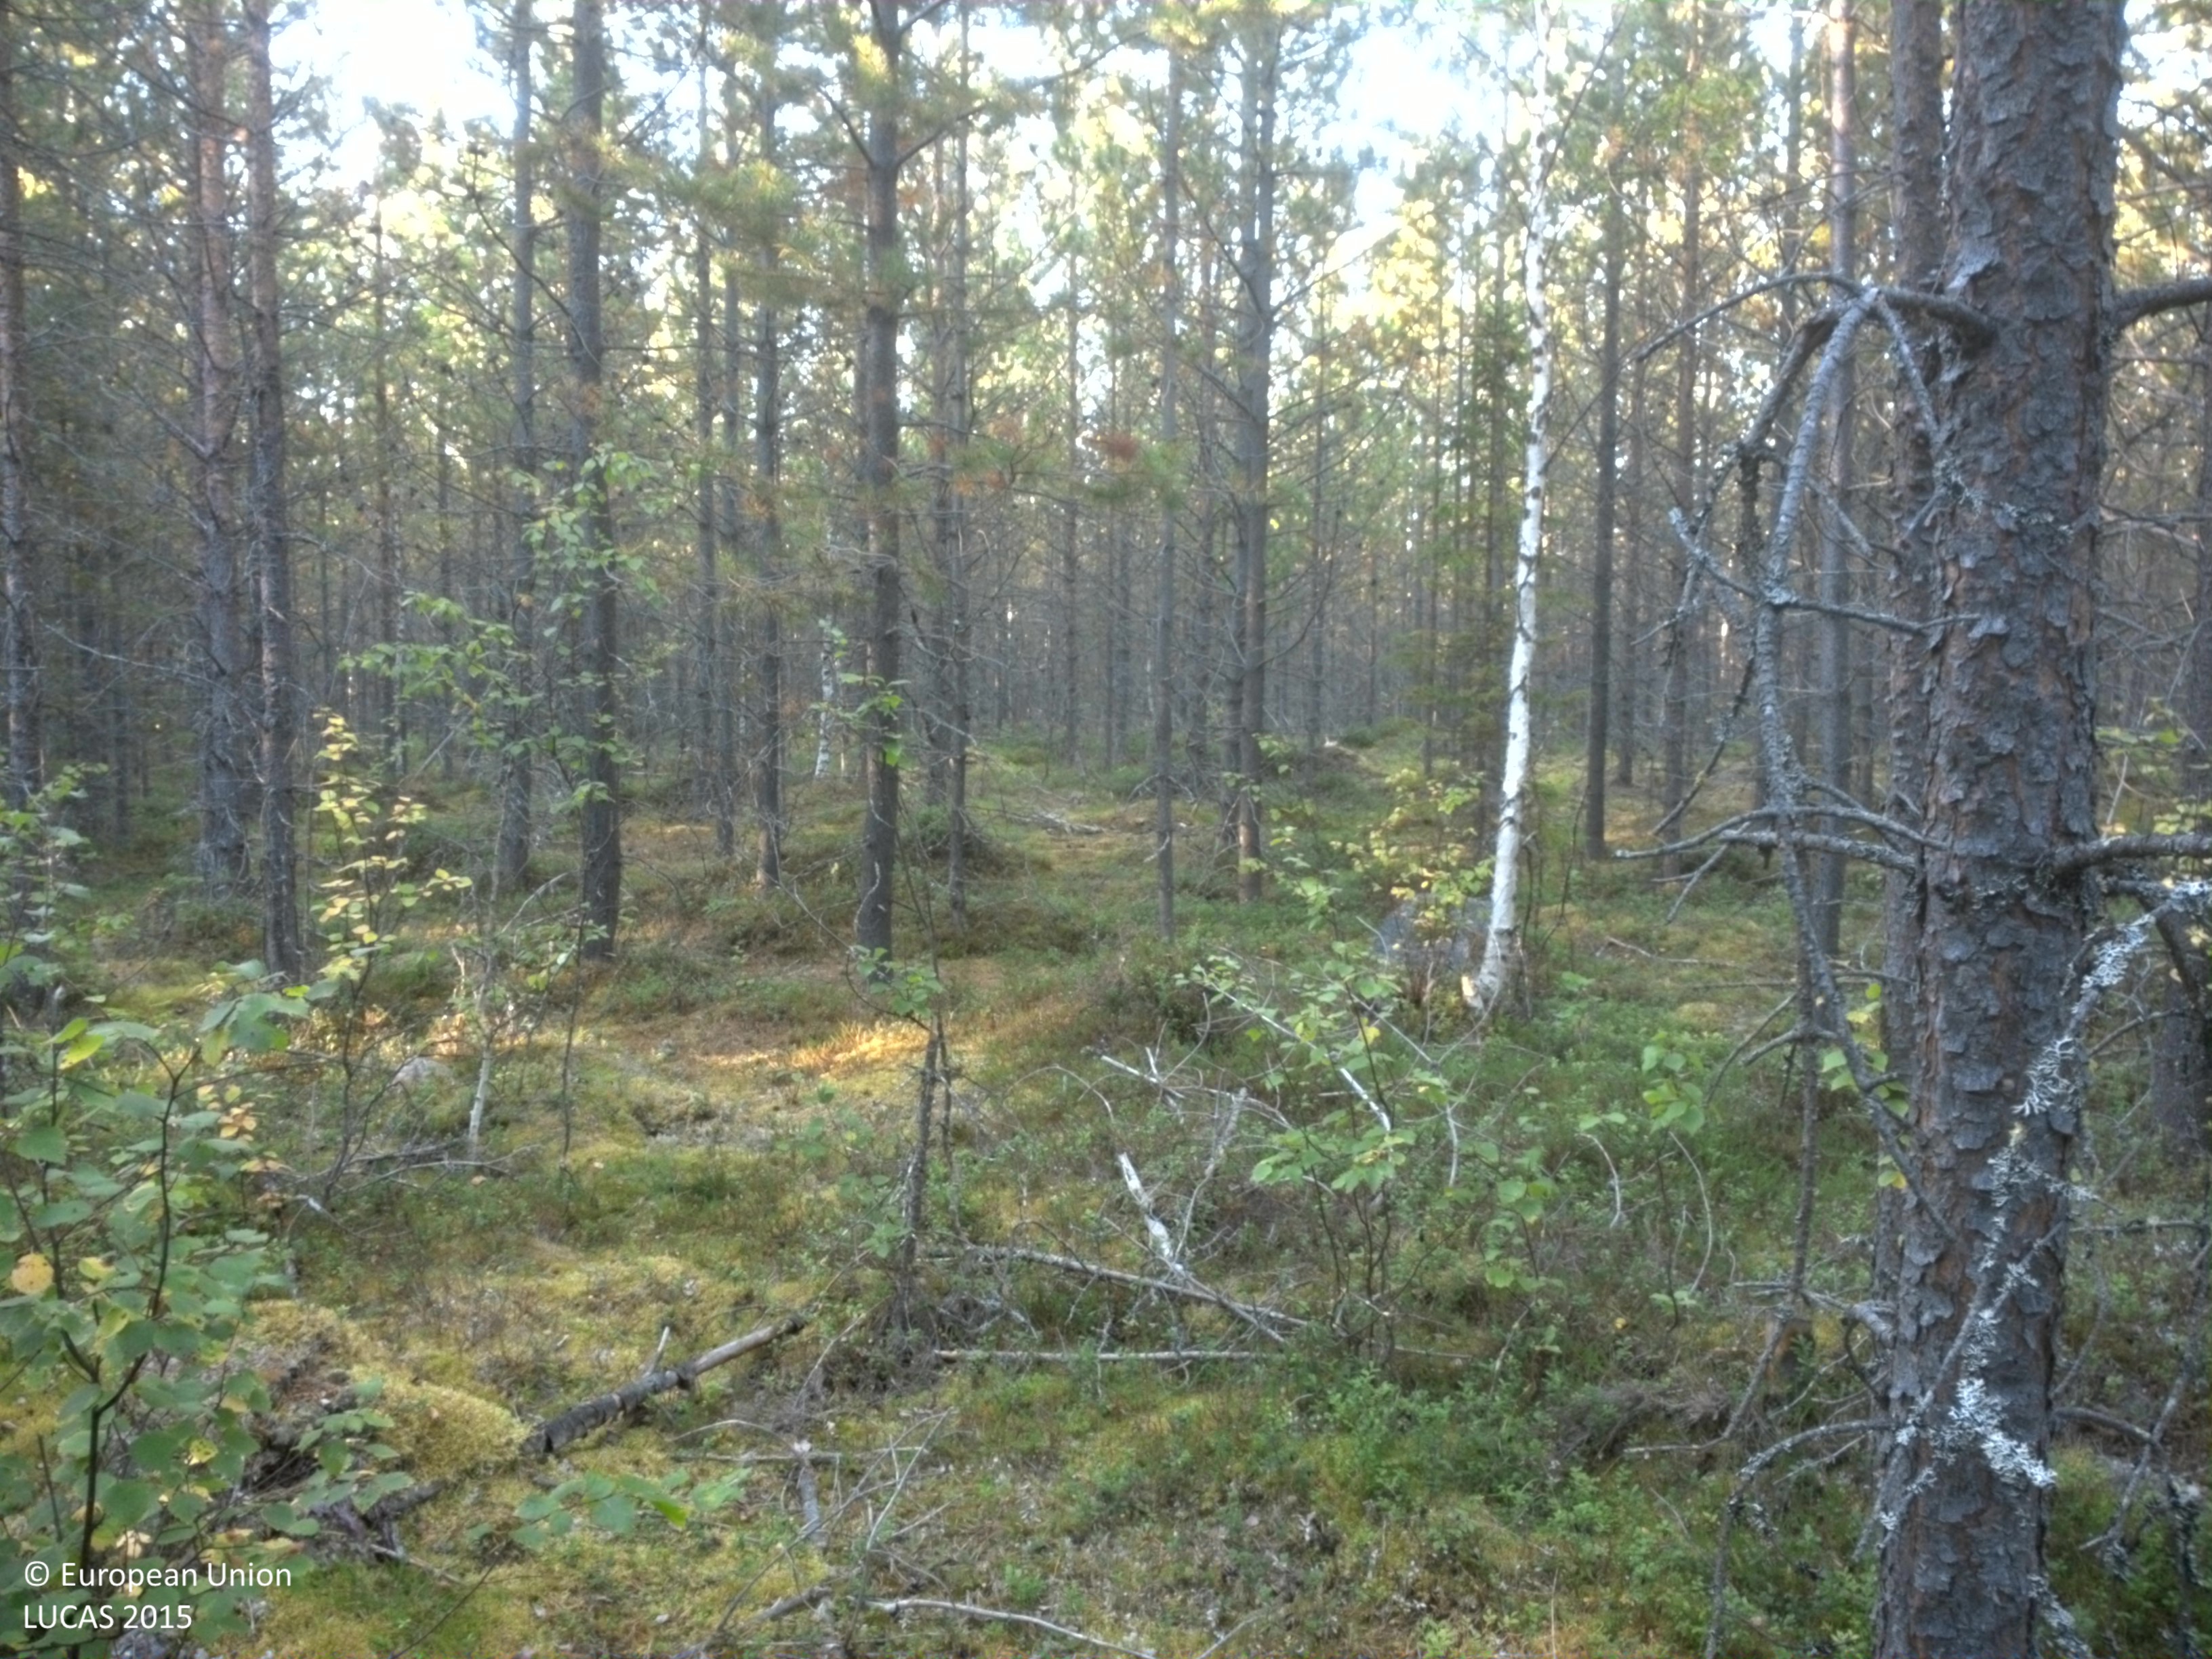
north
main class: Woodland
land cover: Pine dominated coniferous woodland
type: exotic forest
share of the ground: > 75 %
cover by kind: coniferous forest trees 70 %, lichens and mosses 15 %, shrubs 10 %, broadleaved forest trees 5 %
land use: Forestry
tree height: > 5 m
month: September
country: SE
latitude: 64.6931
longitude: 19.8467
